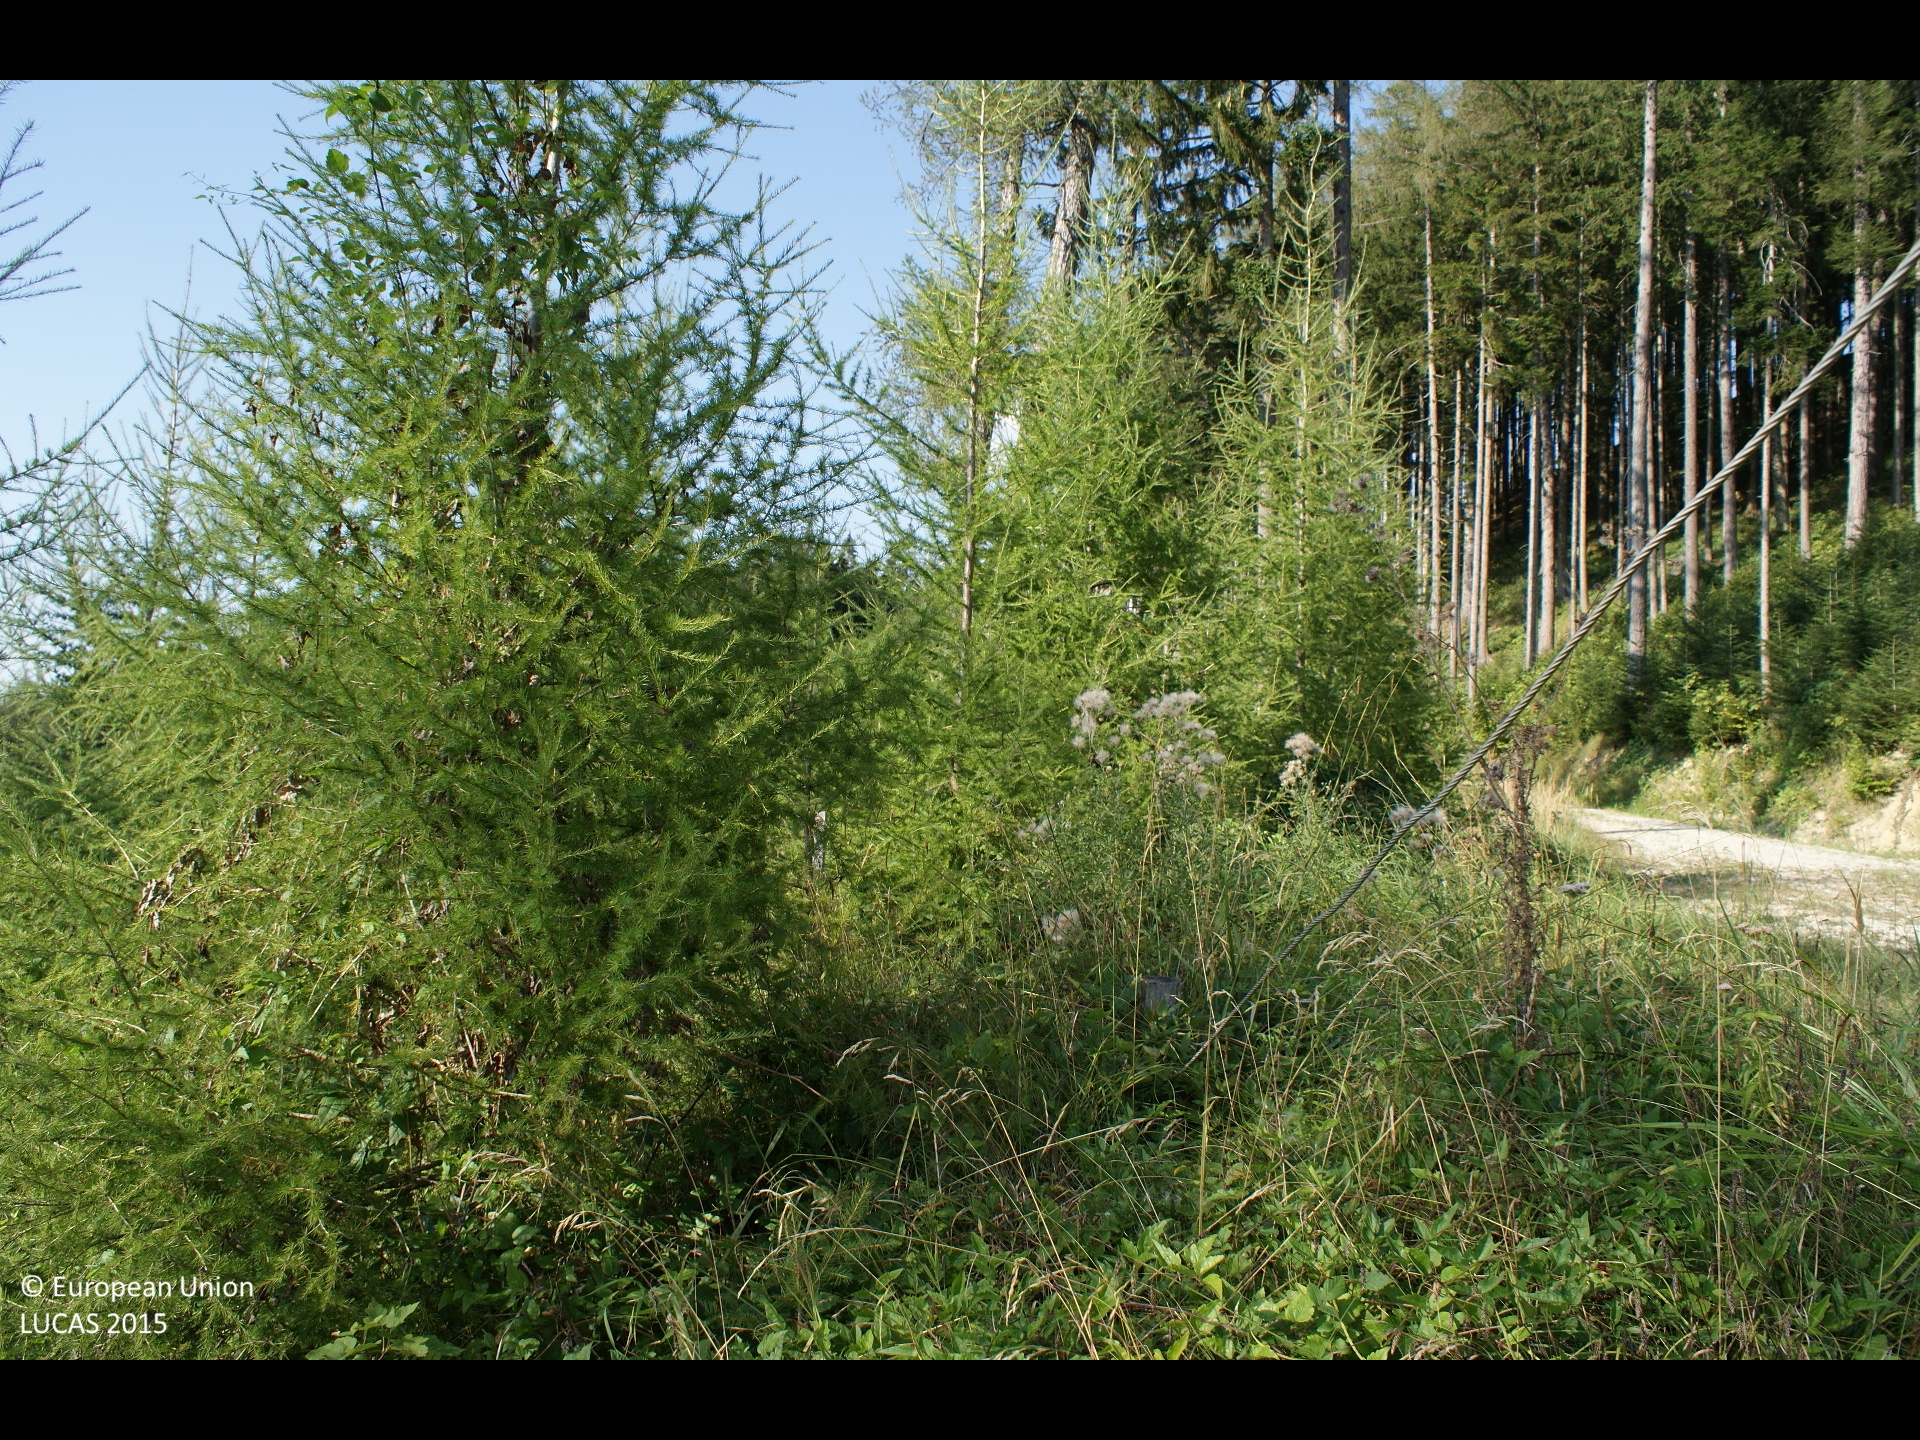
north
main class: Woodland
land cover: Spruce dominated mixed woodland
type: alpine coniferous forest
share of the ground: > 75 %
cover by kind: coniferous forest trees 65 %, broadleaved forest trees 25 %, shrubs 10 %
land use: Forestry
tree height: < 5 m
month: August
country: AT
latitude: 47.9168
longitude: 14.0003
